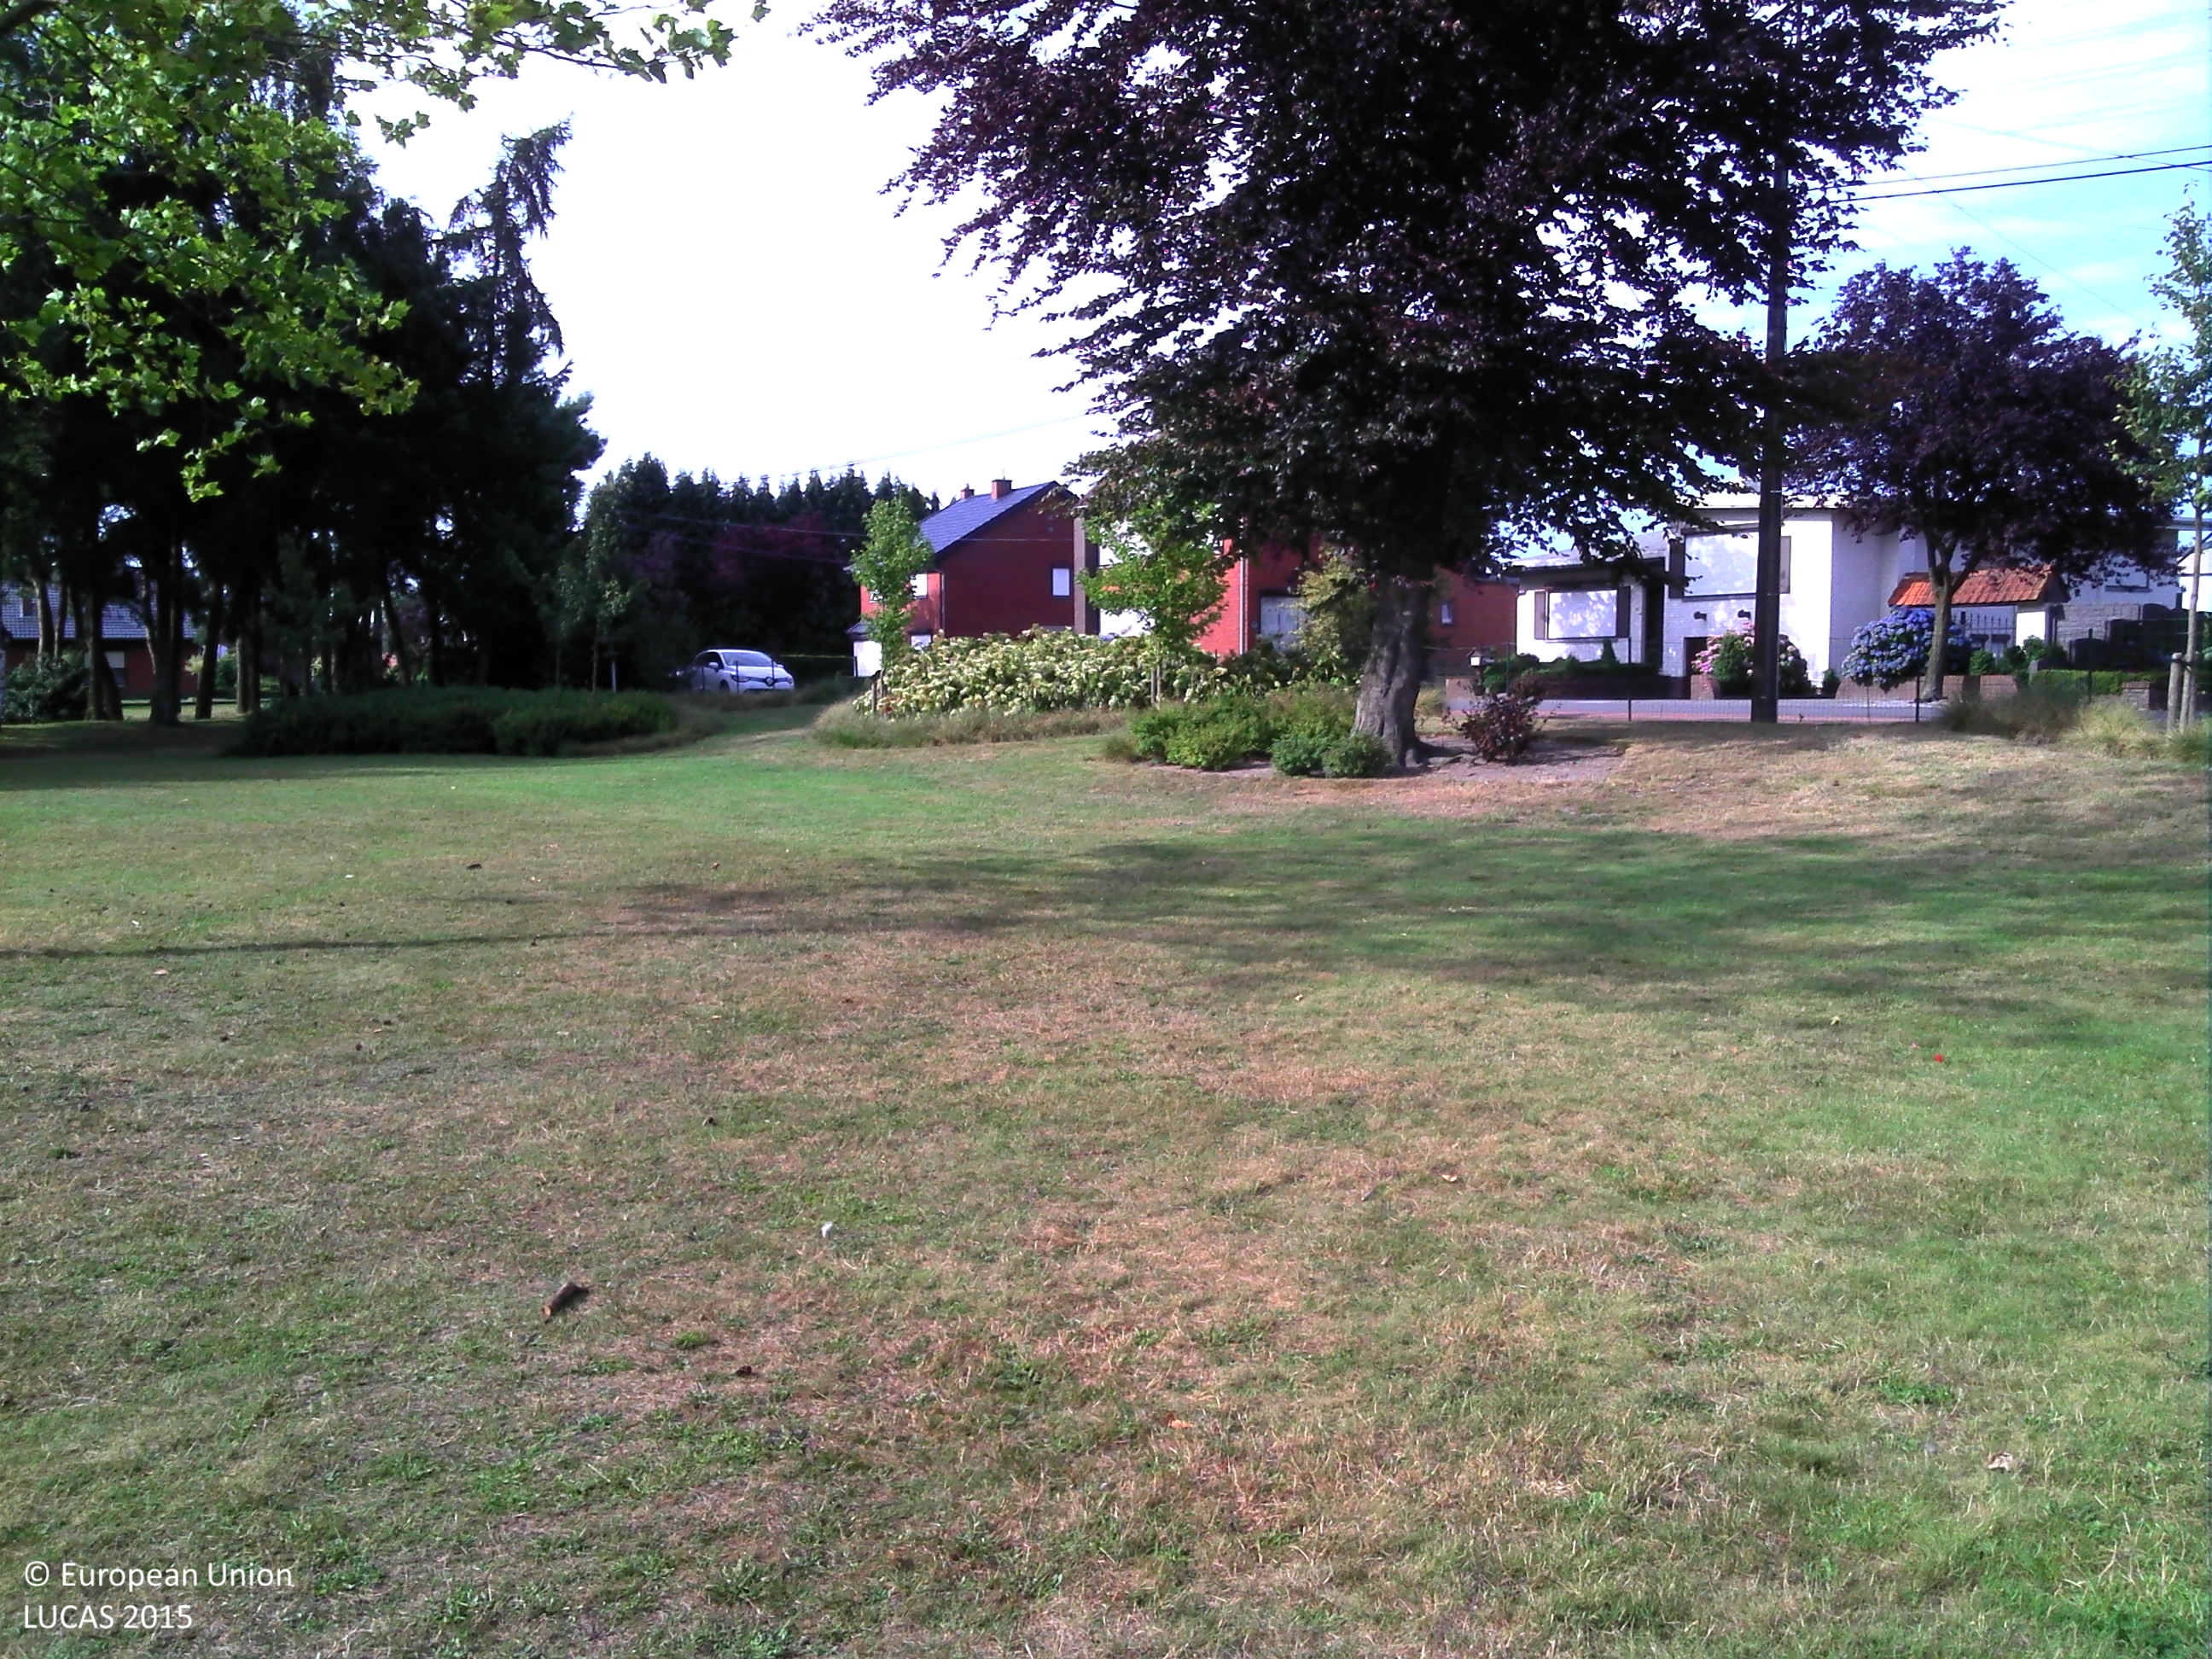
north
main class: Grassland
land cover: Grassland without tree/shrub cover
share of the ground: > 75 %
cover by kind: herbaceous plants 100 %
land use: Amenities, museums, leisure
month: August
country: BE
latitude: 51.1061
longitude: 5.5564
